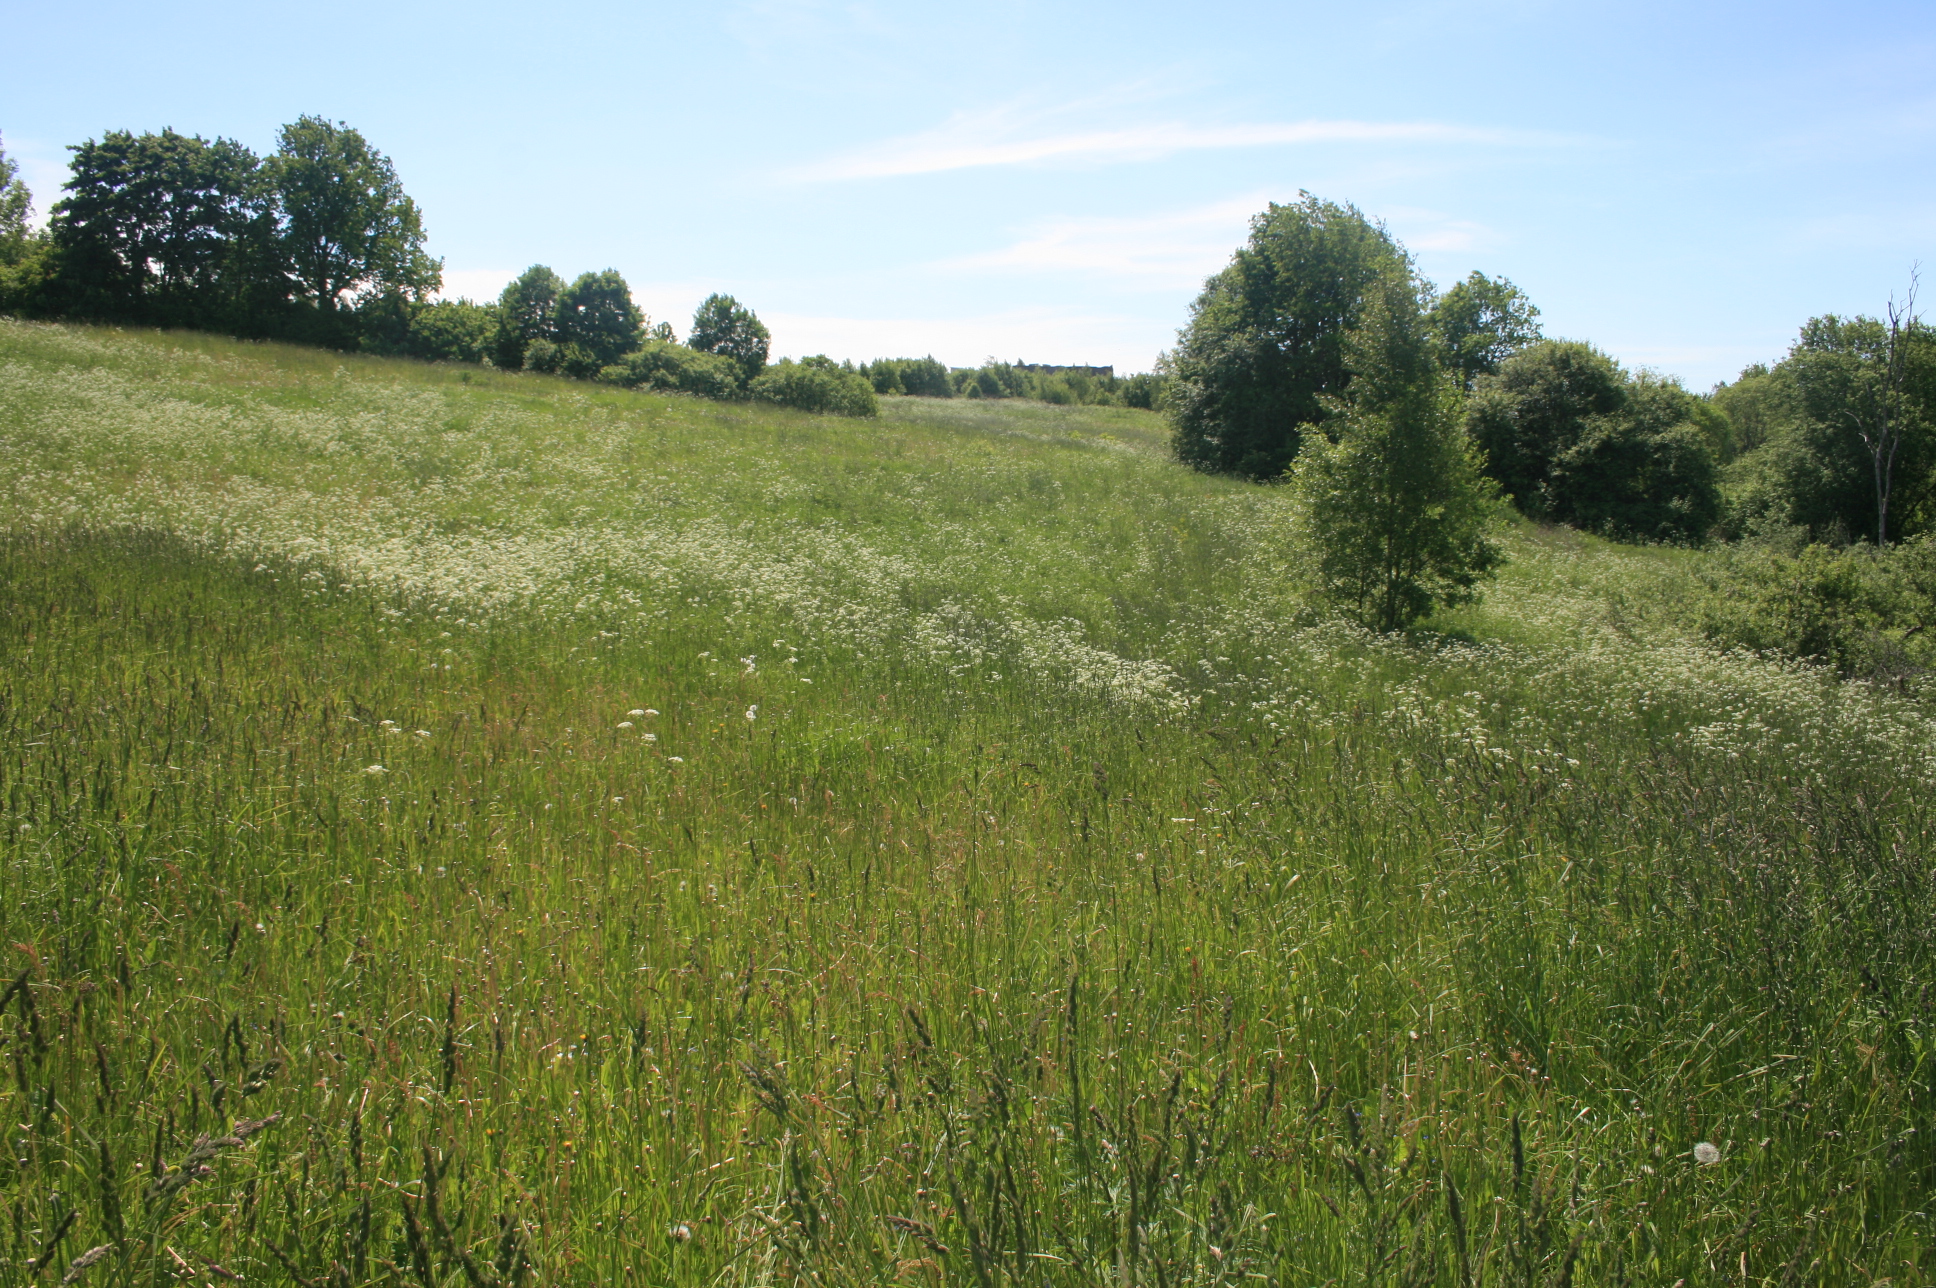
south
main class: Grassland
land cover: Grassland without tree/shrub cover
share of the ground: > 75 %
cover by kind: herbaceous plants 100 %
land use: Agriculture (excluding fallow land and kitchen gardens)
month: June
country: LT
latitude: 55.9005
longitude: 22.3238
